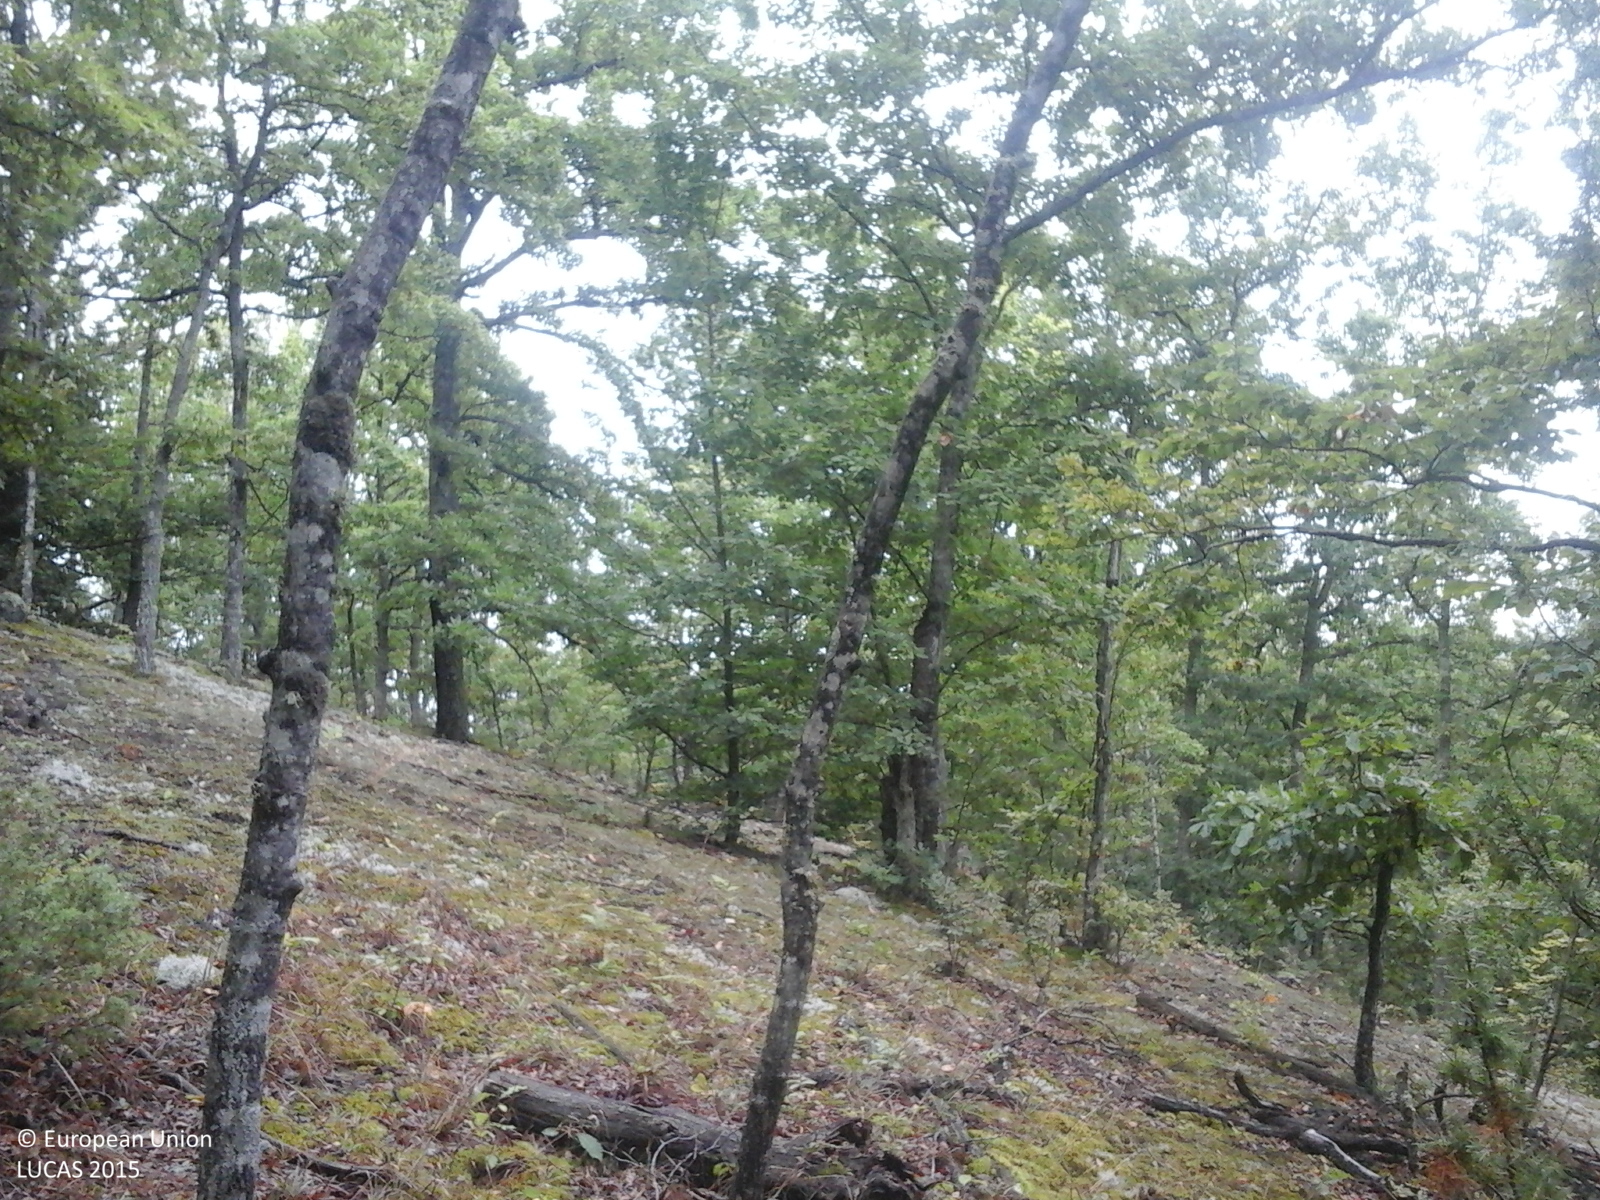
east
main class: Woodland
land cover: Broadleaved woodland
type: acidophilous oak and oak-birch forest
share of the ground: > 75 %
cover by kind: broadleaved forest trees 100 %
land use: Forestry
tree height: > 5 m
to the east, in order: Broadleaved woodland; Ditches and canals; Broadleaved woodland; Grassland without tree/shrub cover
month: September
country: RO
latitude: 45.7393
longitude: 22.2139
